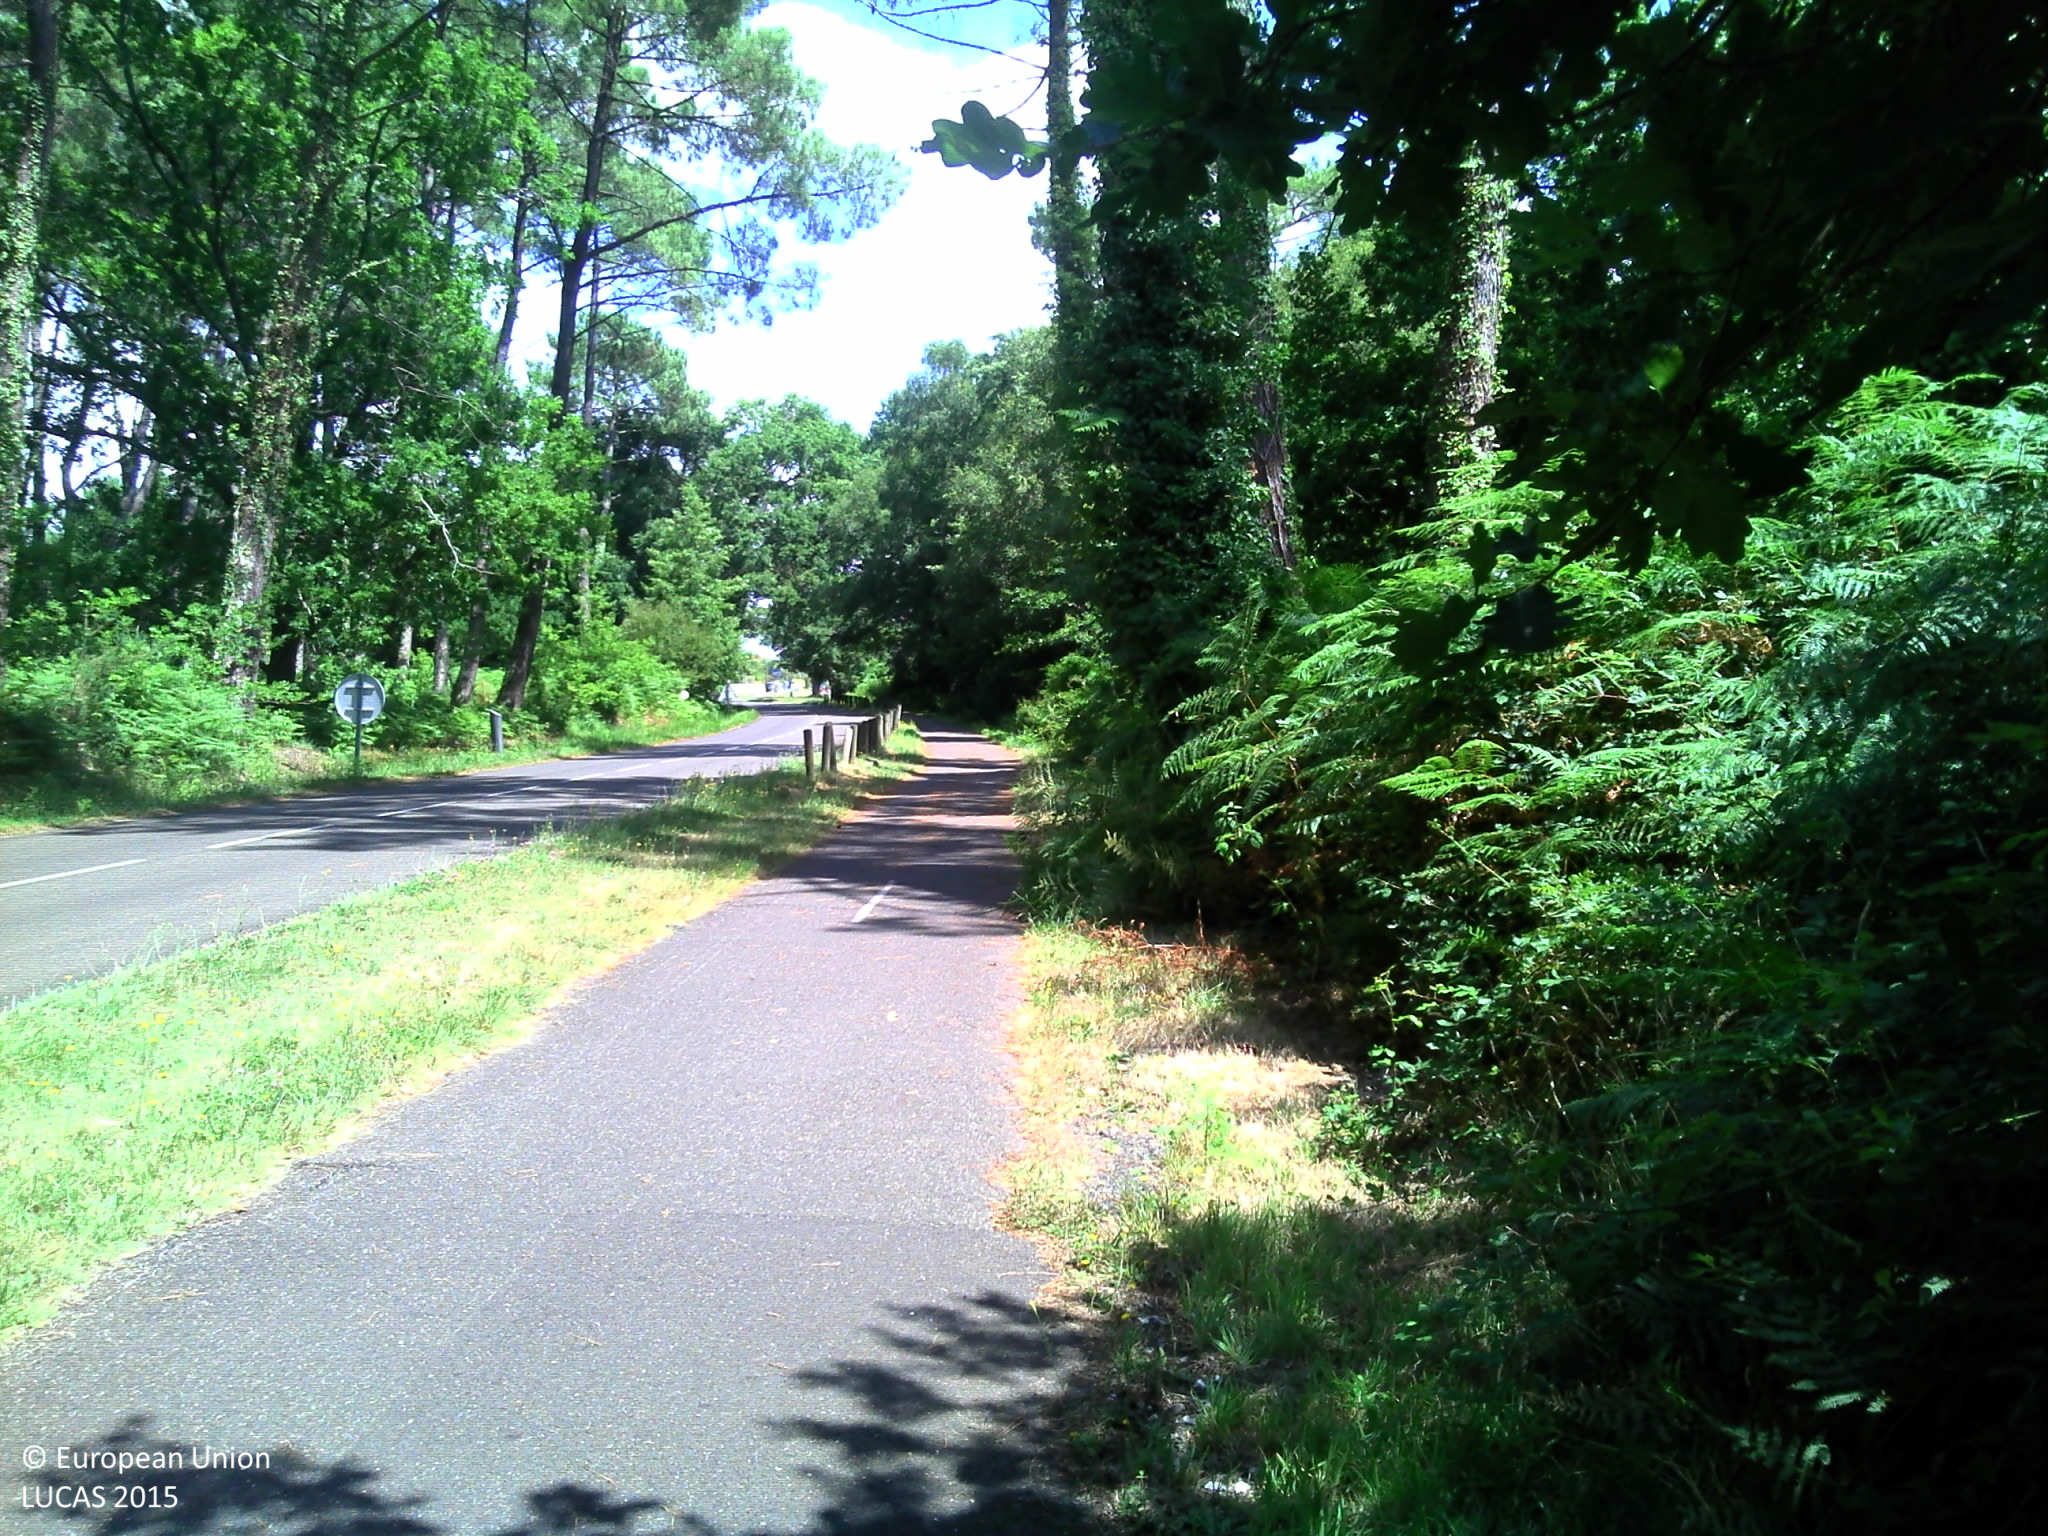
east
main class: Woodland
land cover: Broadleaved woodland
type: thermophilous deciduous forest
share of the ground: > 75 %
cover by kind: broadleaved forest trees 80 %, shrubs 10 %, herbaceous plants 10 %
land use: Forestry
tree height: > 5 m
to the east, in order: Broadleaved woodland; Grass margins; Paved roads, cycling and walking lanes; Grassland without tree/shrub cover; Paved roads, cycling and walking lanes; Grassland with sparse tree/shrub cover; Paved roads, cycling and walking lanes; Broadleaved woodland
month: July
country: FR
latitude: 44.0801
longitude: -1.2719
